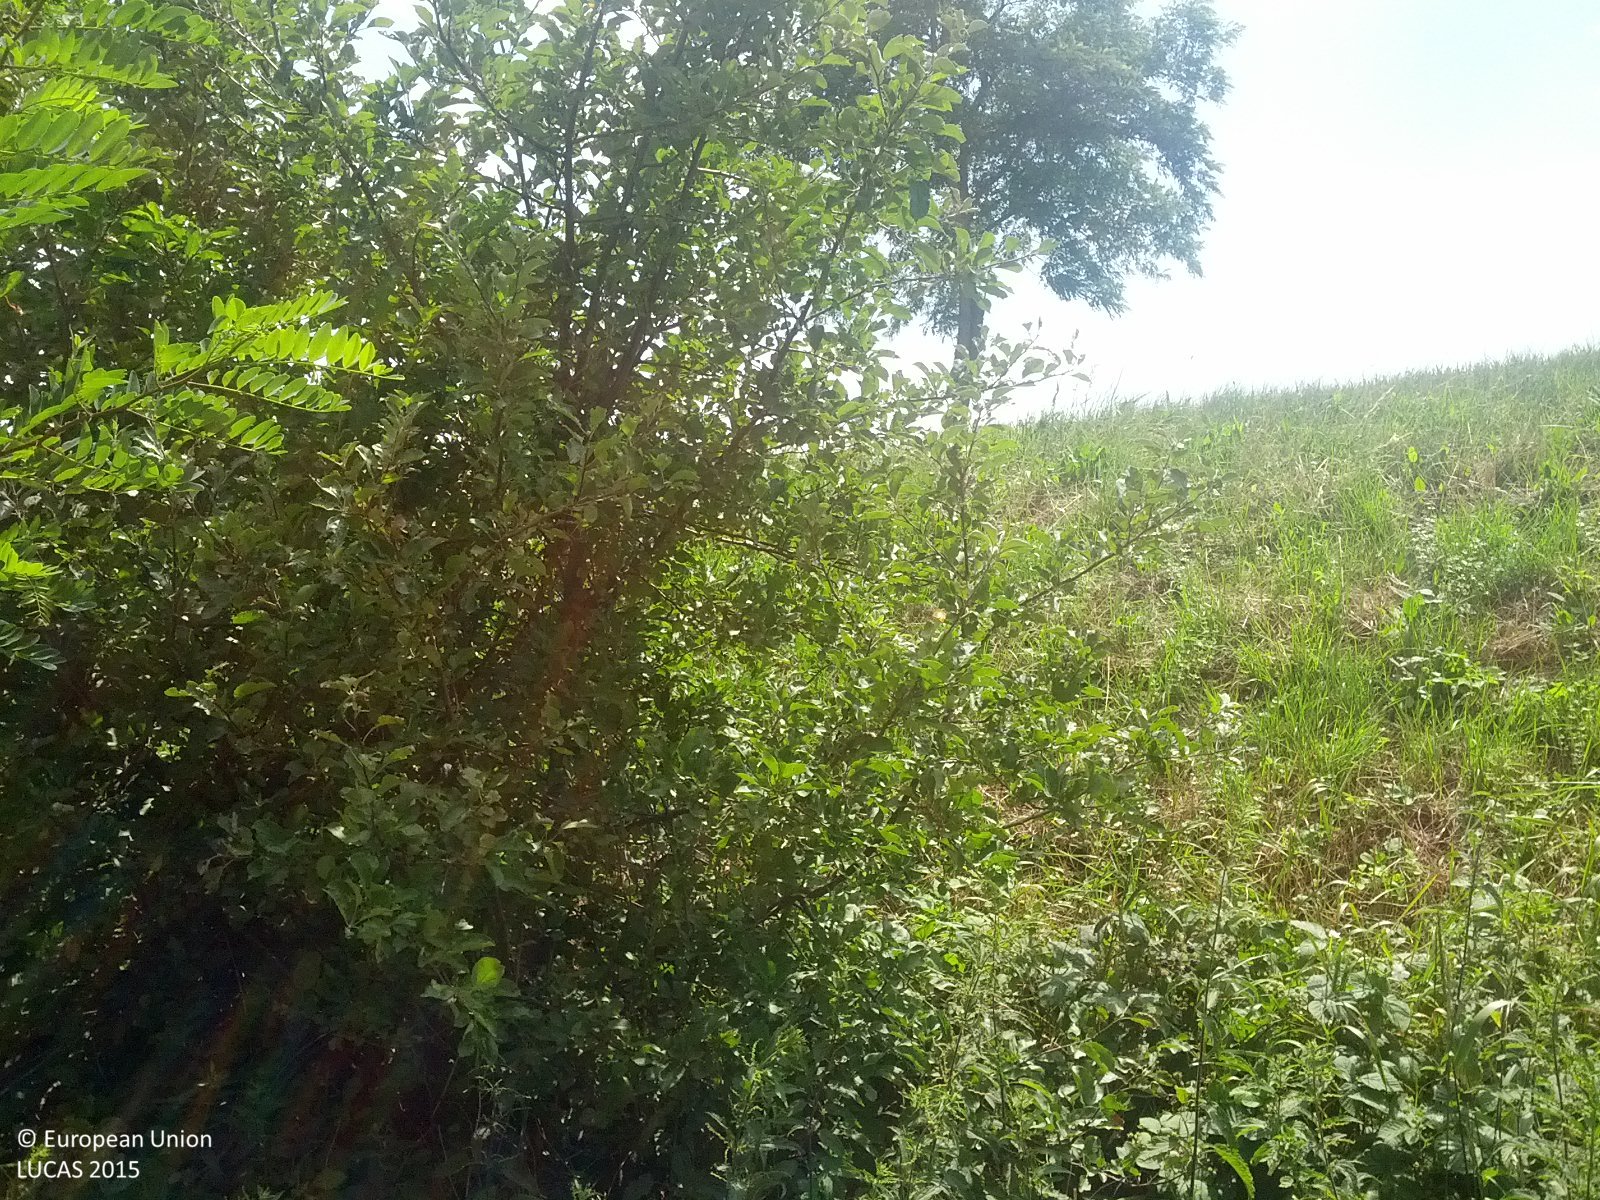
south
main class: Cropland
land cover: Common wheat
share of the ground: > 75 %
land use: Agriculture (excluding fallow land and kitchen gardens)
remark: Harvested field
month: July
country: AT
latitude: 47.2574
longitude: 16.4650
